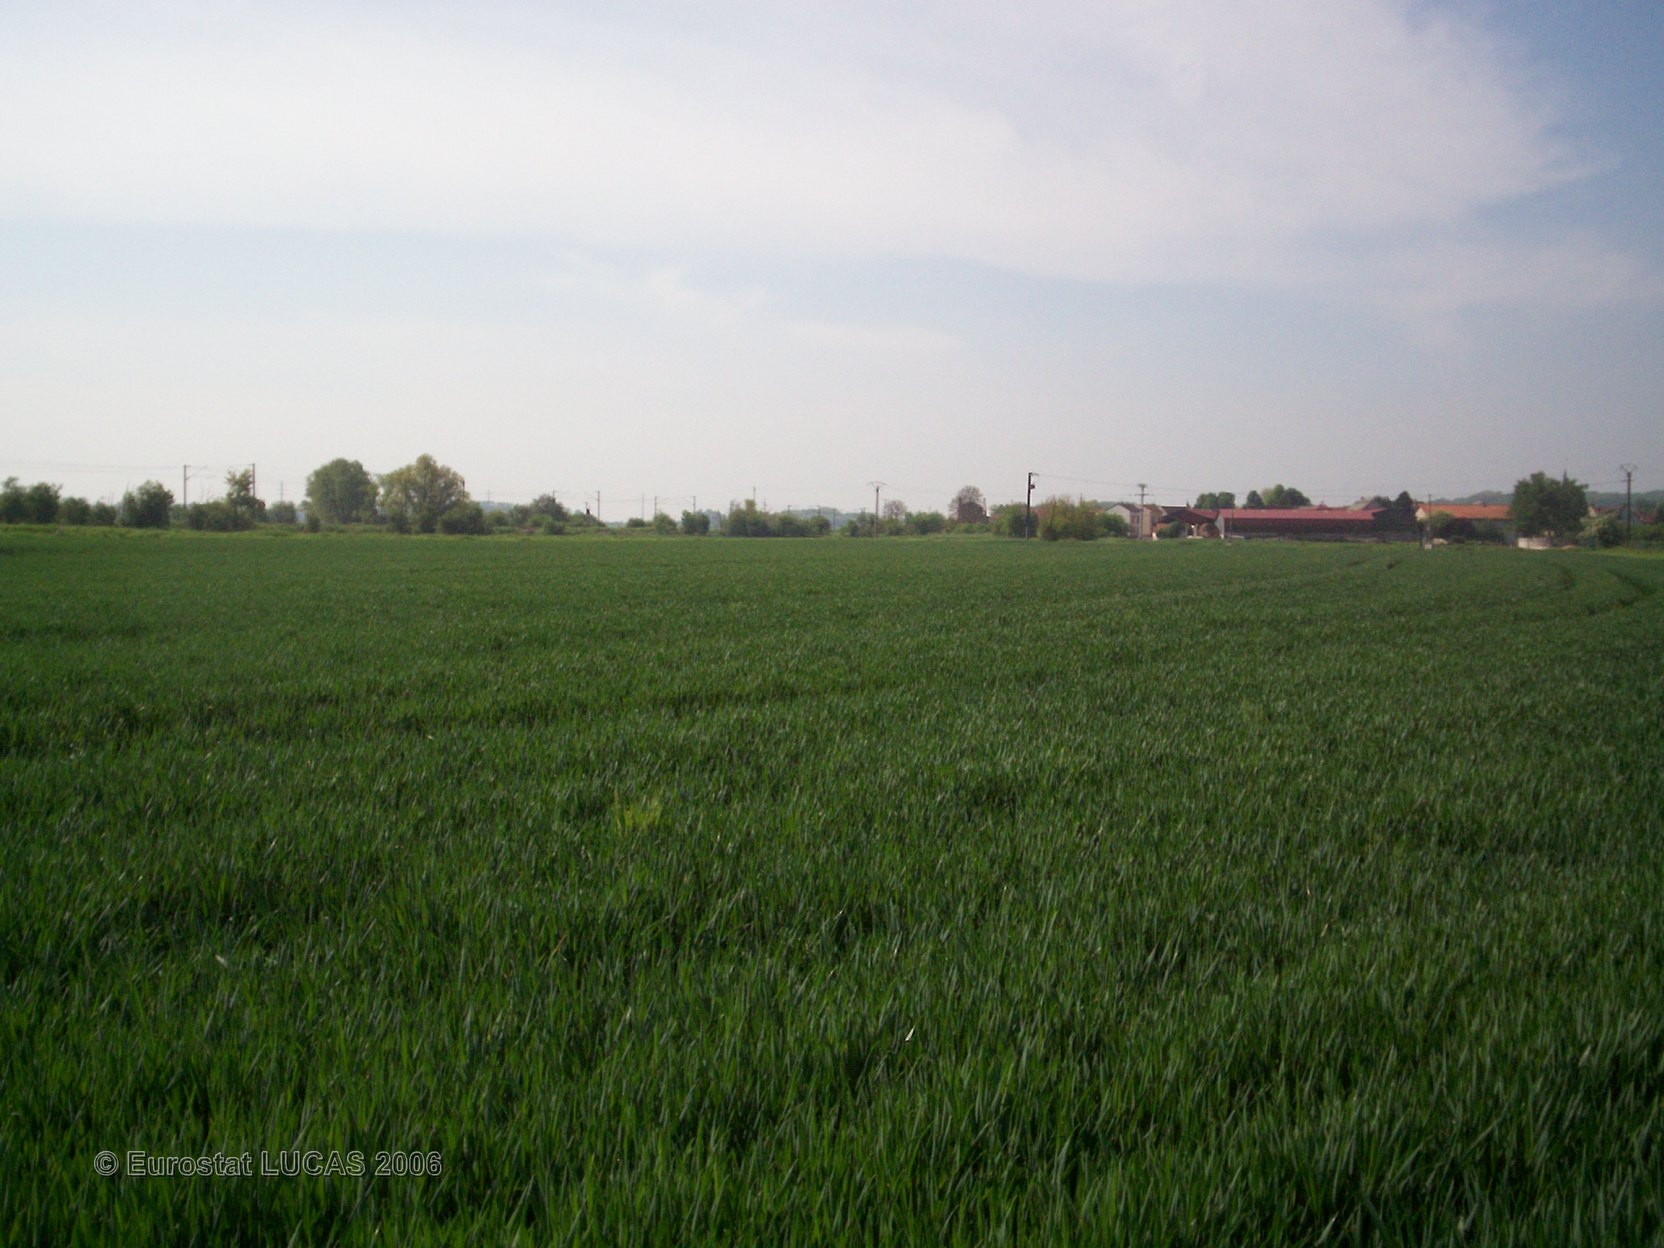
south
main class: Cropland
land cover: Common wheat
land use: Agriculture (excluding fallow land and kitchen gardens)
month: May
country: FR
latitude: 49.0667
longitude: 2.7218
